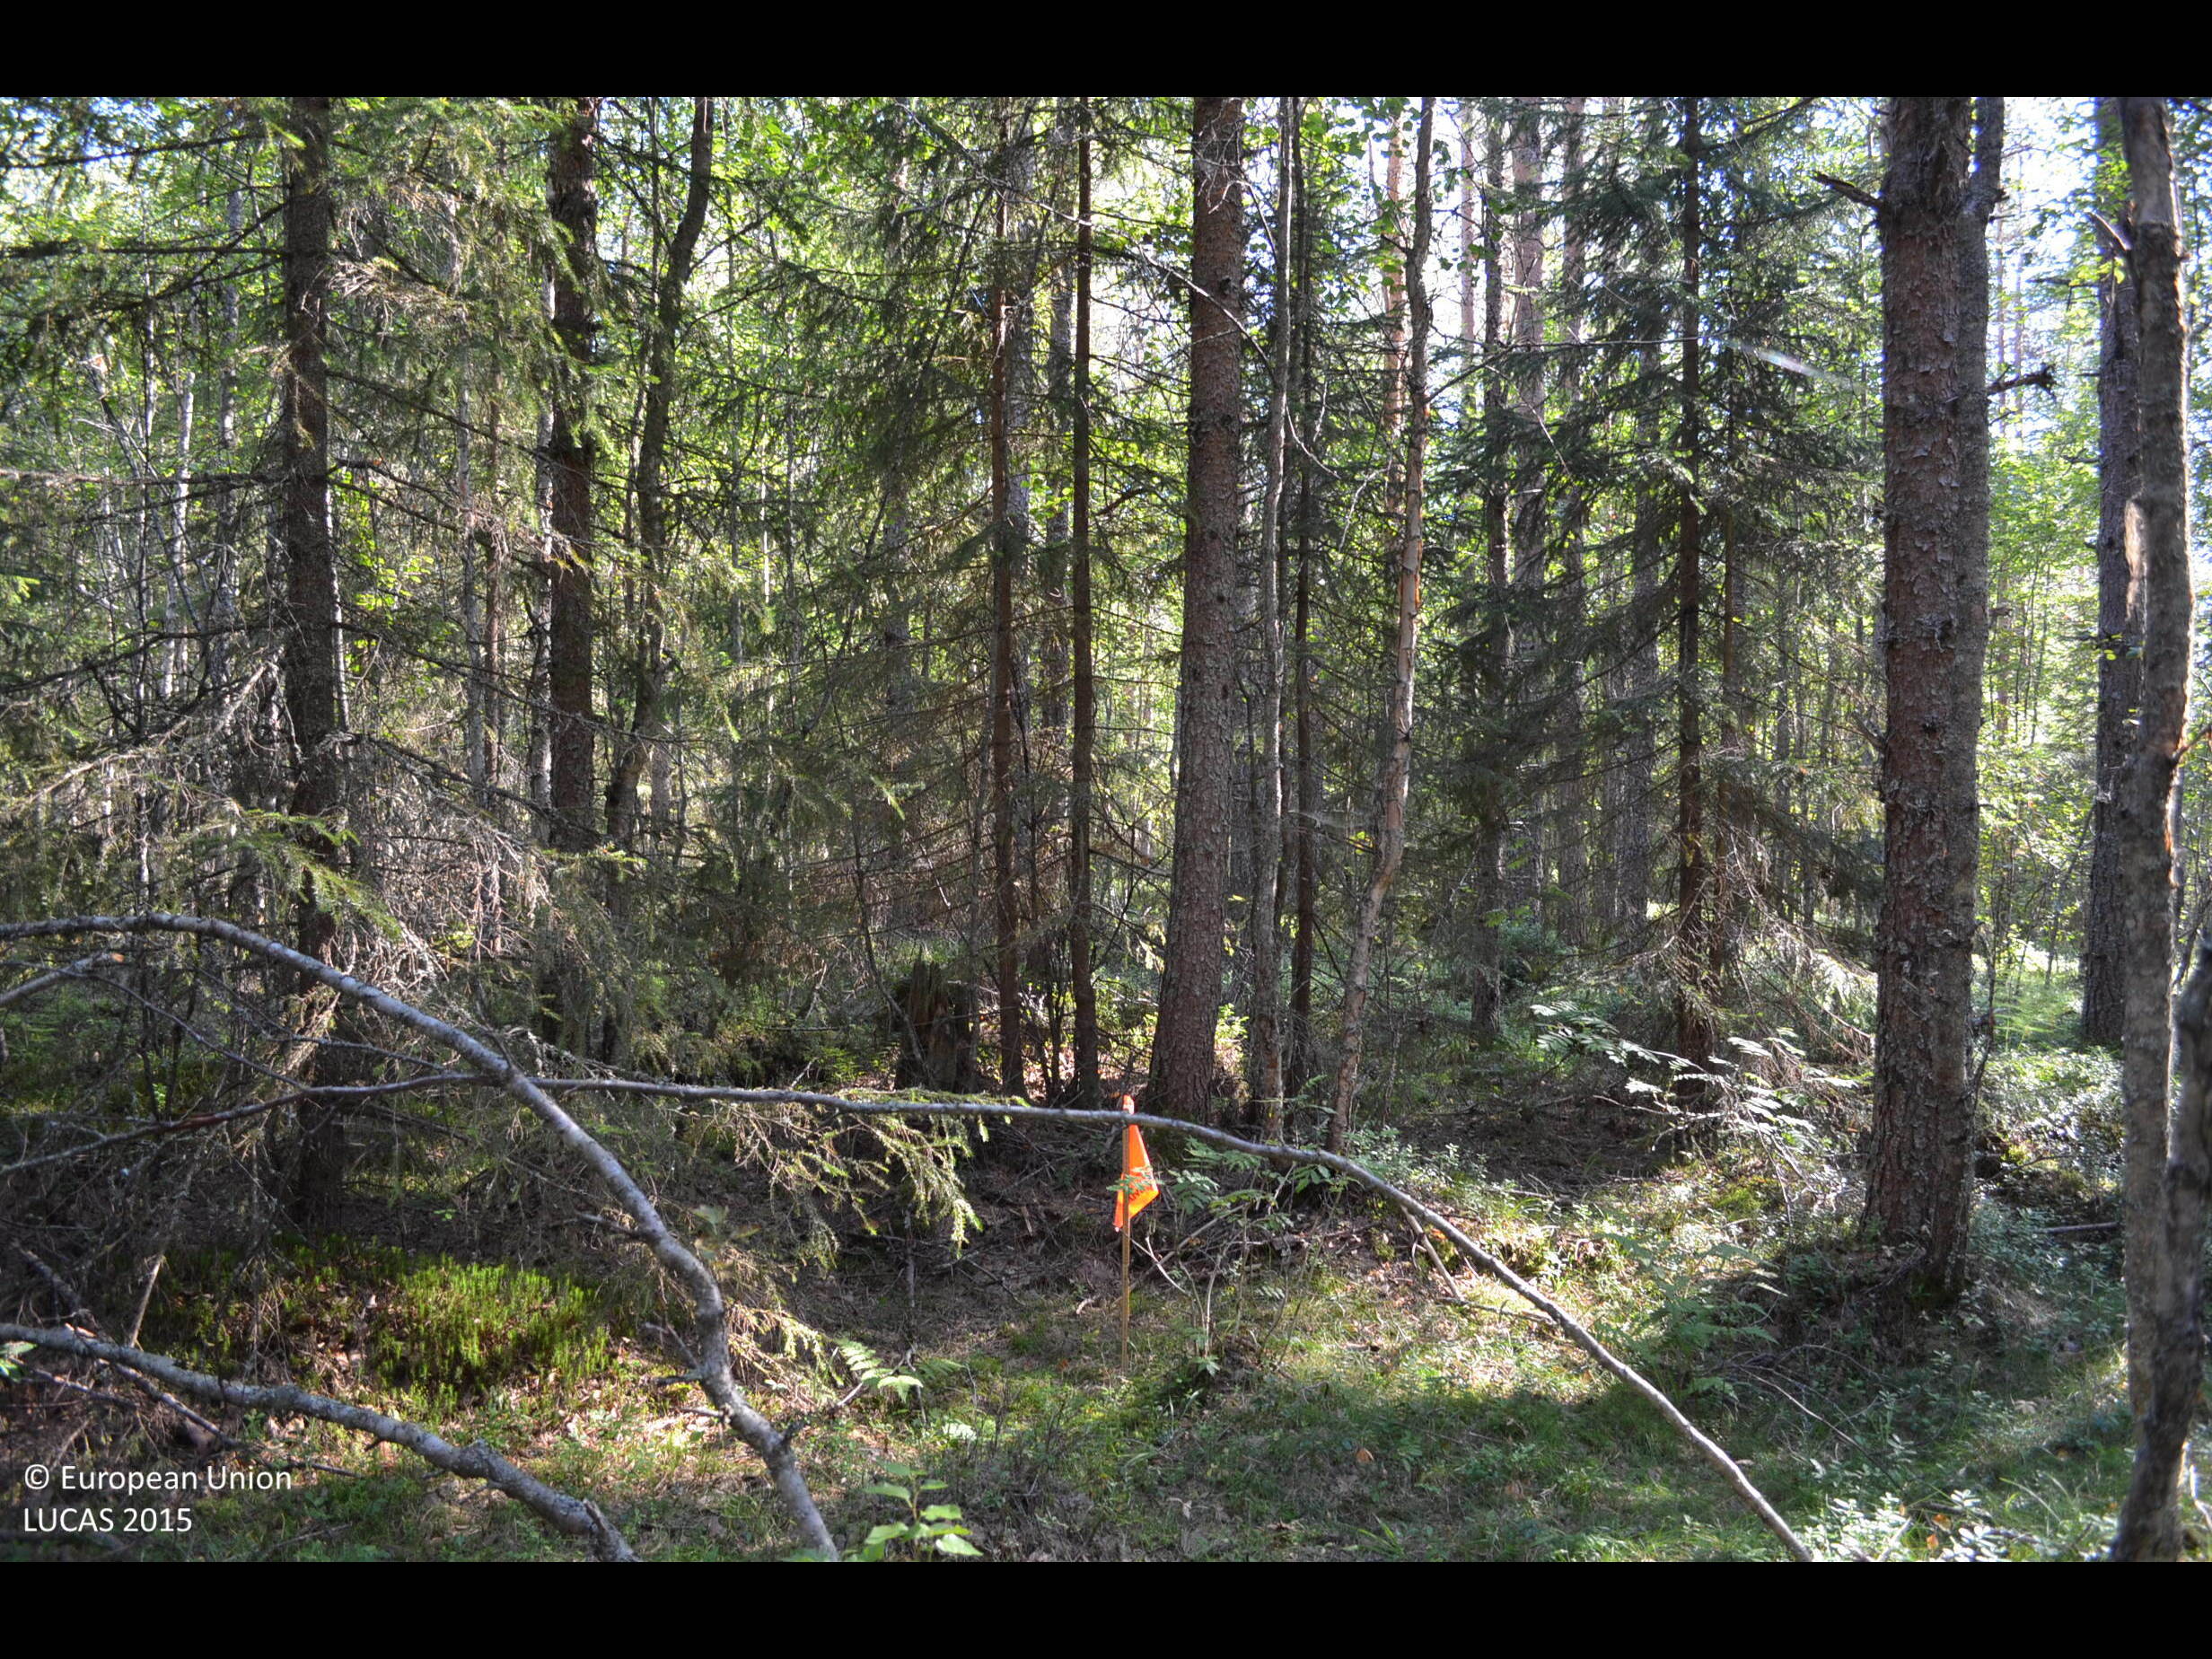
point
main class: Woodland
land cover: Pine dominated mixed woodland
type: boreal forest
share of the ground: > 75 %
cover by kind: coniferous forest trees 60 %, broadleaved forest trees 25 %, shrubs 5 %, lichens and mosses 5 %
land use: Forestry
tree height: > 5 m
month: August
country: FI
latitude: 62.4723
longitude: 24.3418
